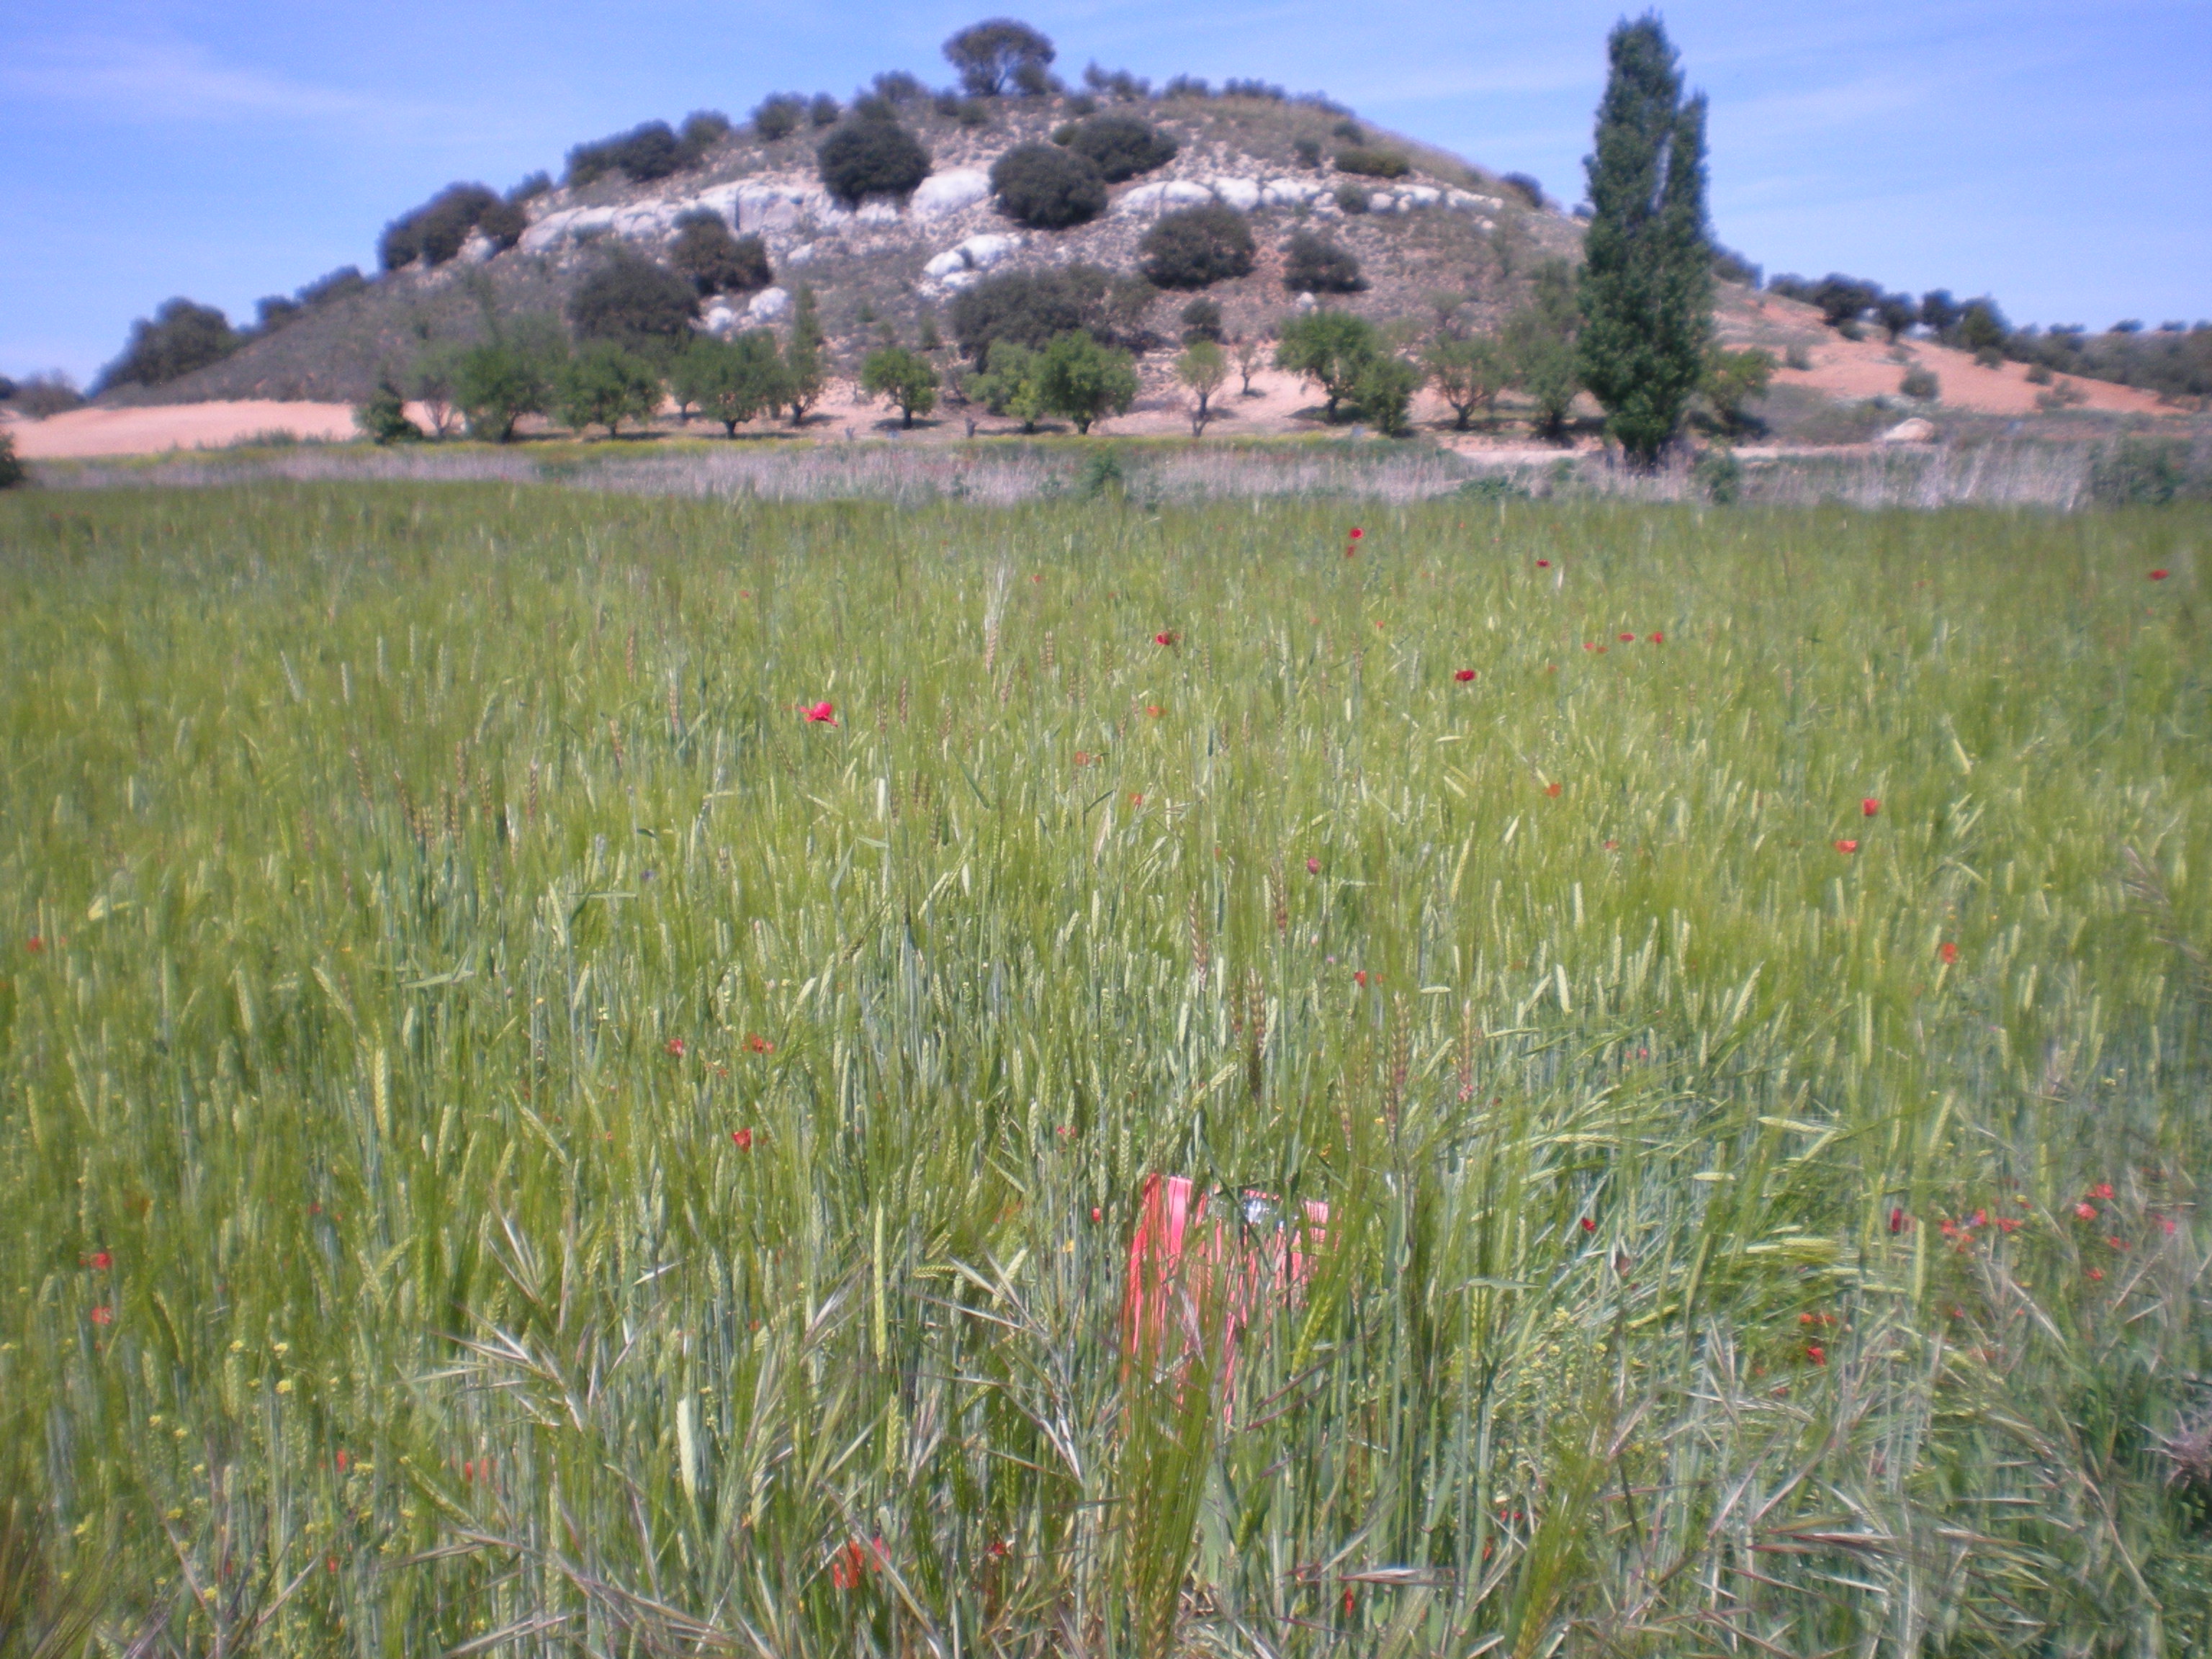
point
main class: Cropland
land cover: Barley
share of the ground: > 75 %
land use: Agriculture (excluding fallow land and kitchen gardens)
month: April
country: ES
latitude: 38.5786
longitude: -3.1029
